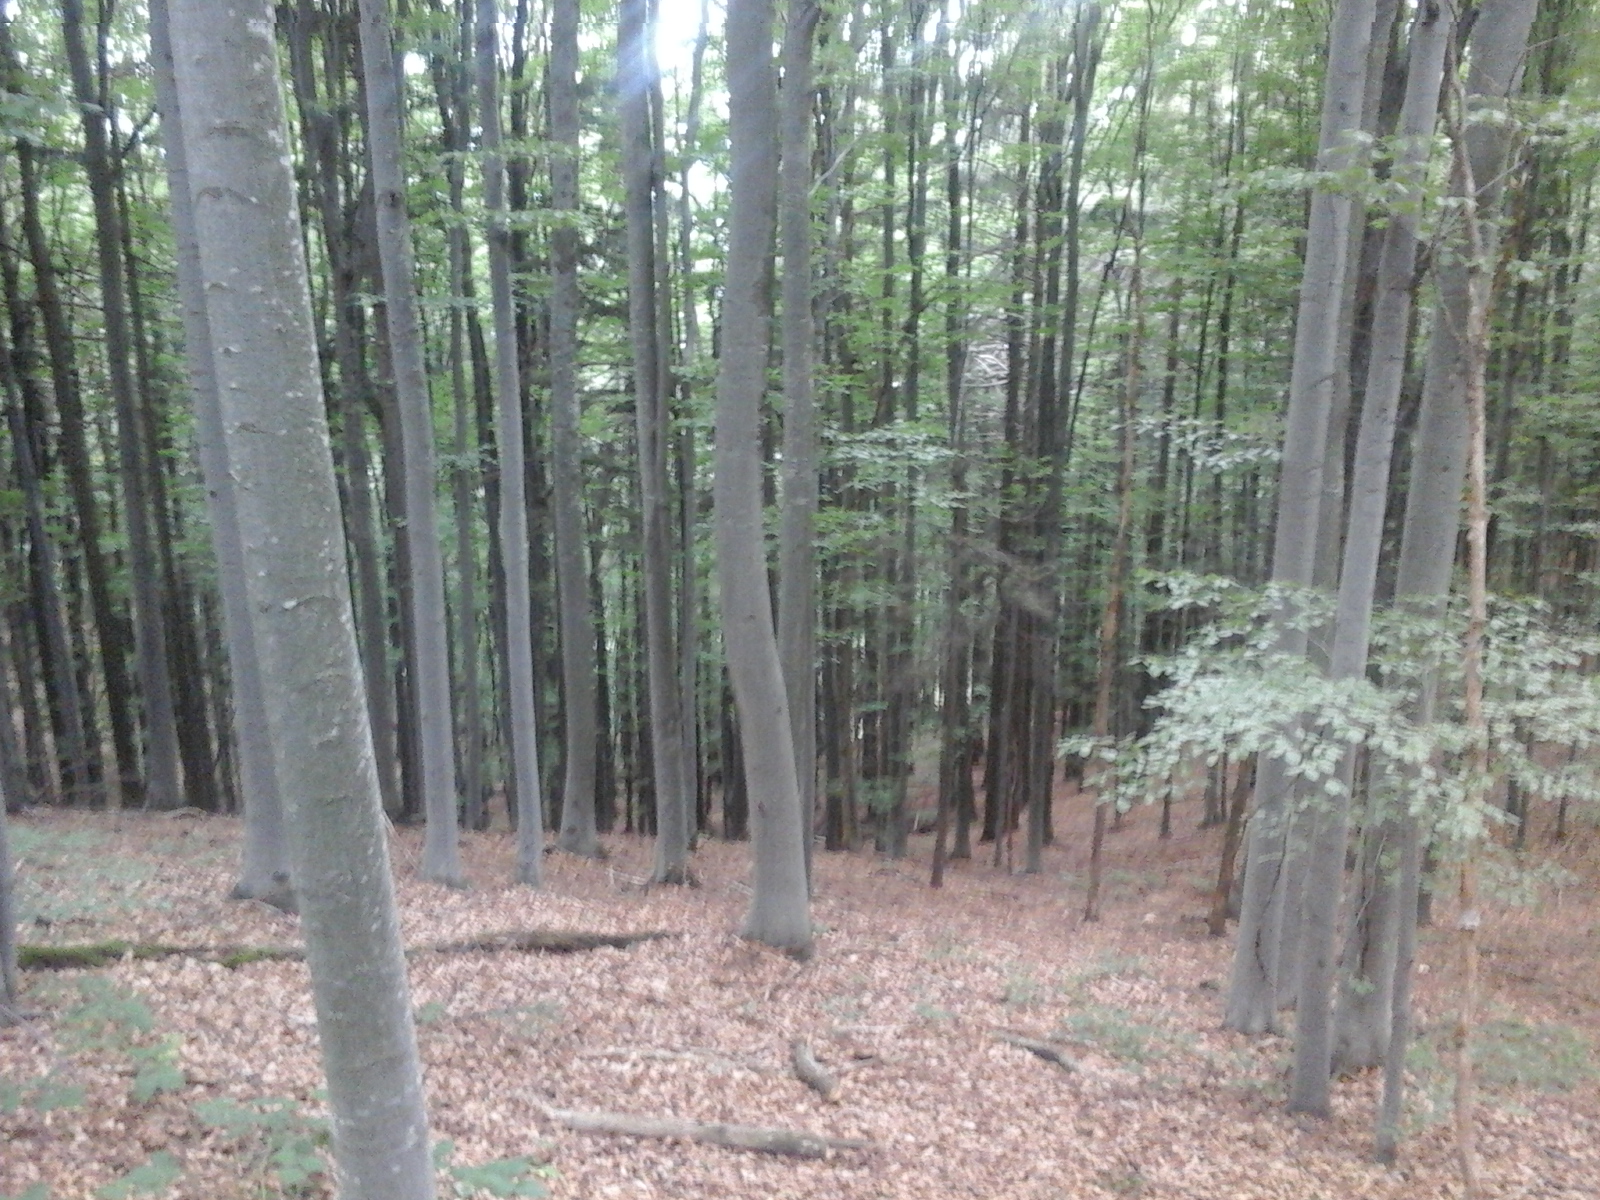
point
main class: Woodland
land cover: Broadleaved woodland
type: beech forest
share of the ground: > 75 %
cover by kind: broadleaved forest trees 100 %
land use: Forestry
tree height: > 5 m
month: August
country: RO
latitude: 45.2275
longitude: 22.0736
